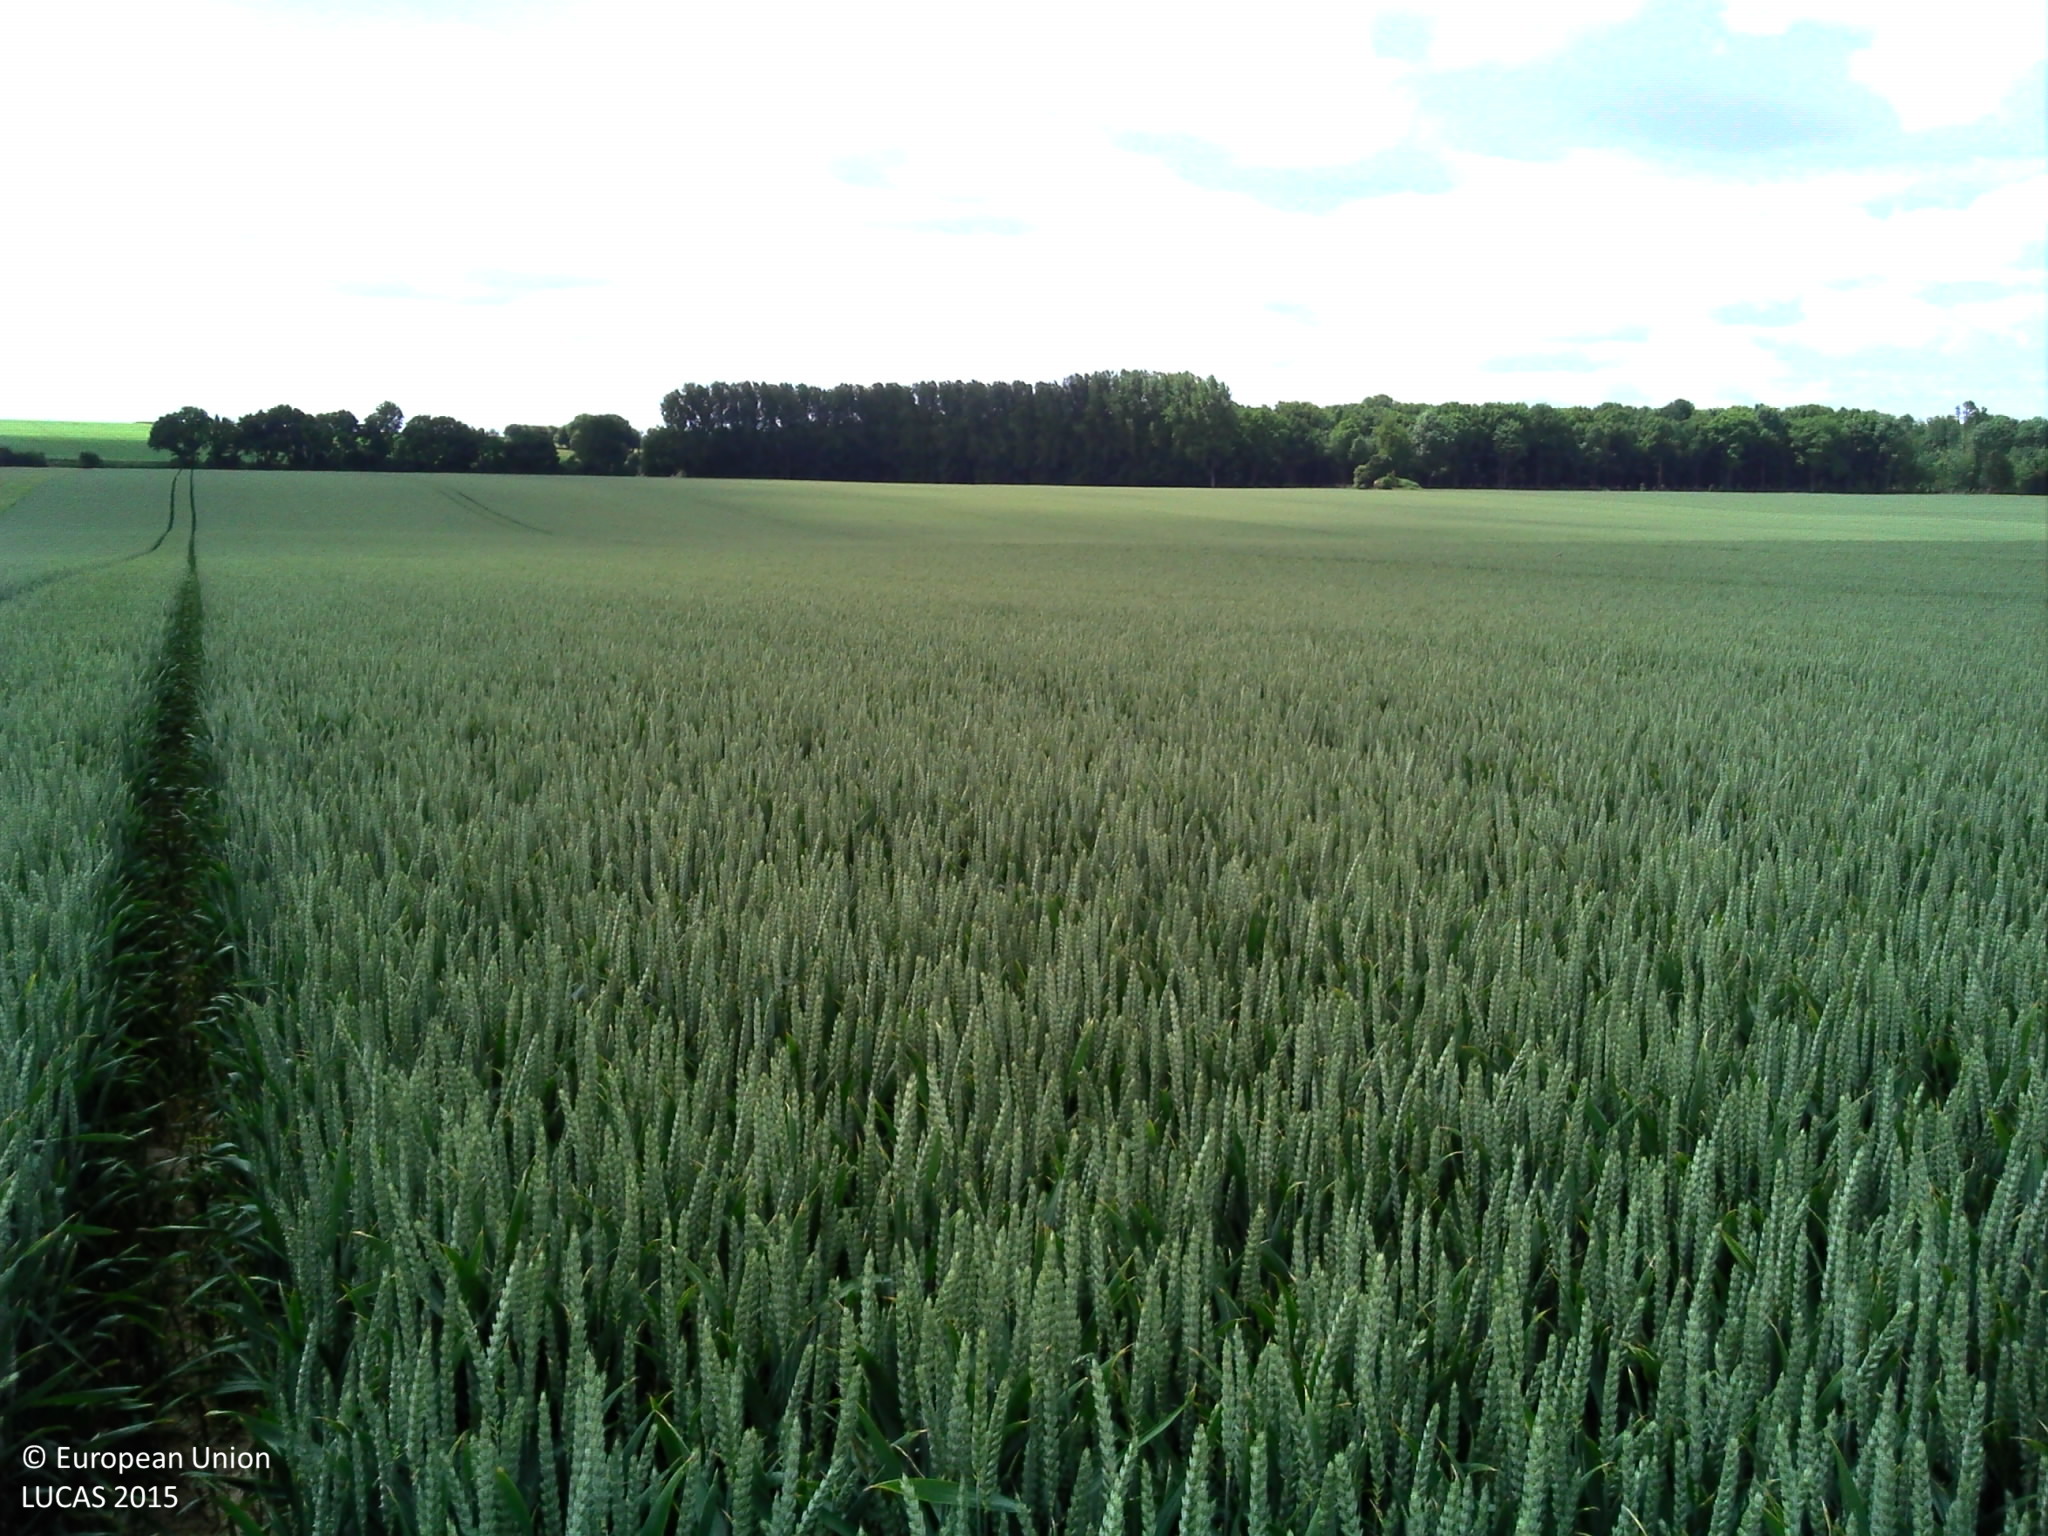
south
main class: Cropland
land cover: Common wheat
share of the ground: > 75 %
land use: Agriculture (excluding fallow land and kitchen gardens)
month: June
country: FR
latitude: 50.3504
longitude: 2.4684
